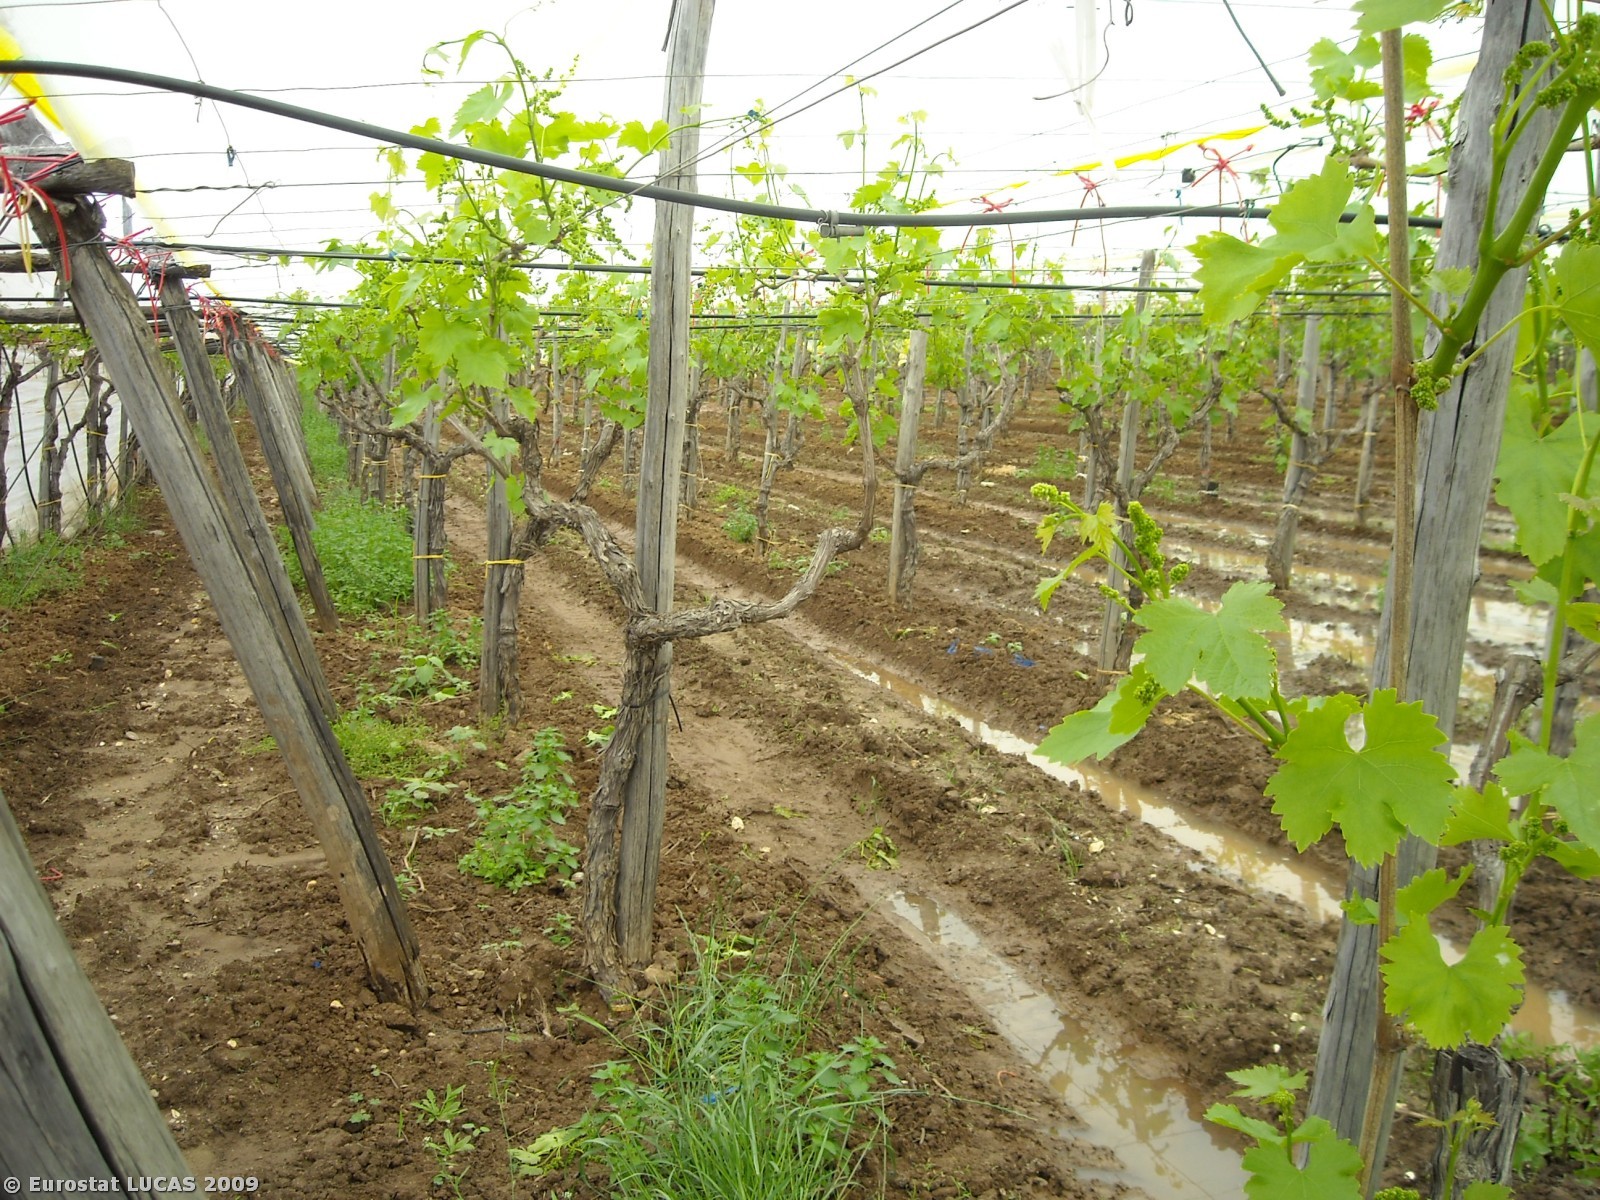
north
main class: Cropland
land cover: Vineyards
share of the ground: 50 - 75 %
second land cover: Bare land
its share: > 75 %
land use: Agriculture (excluding fallow land and kitchen gardens)
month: April
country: IT
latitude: 40.5452
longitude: 16.9780
